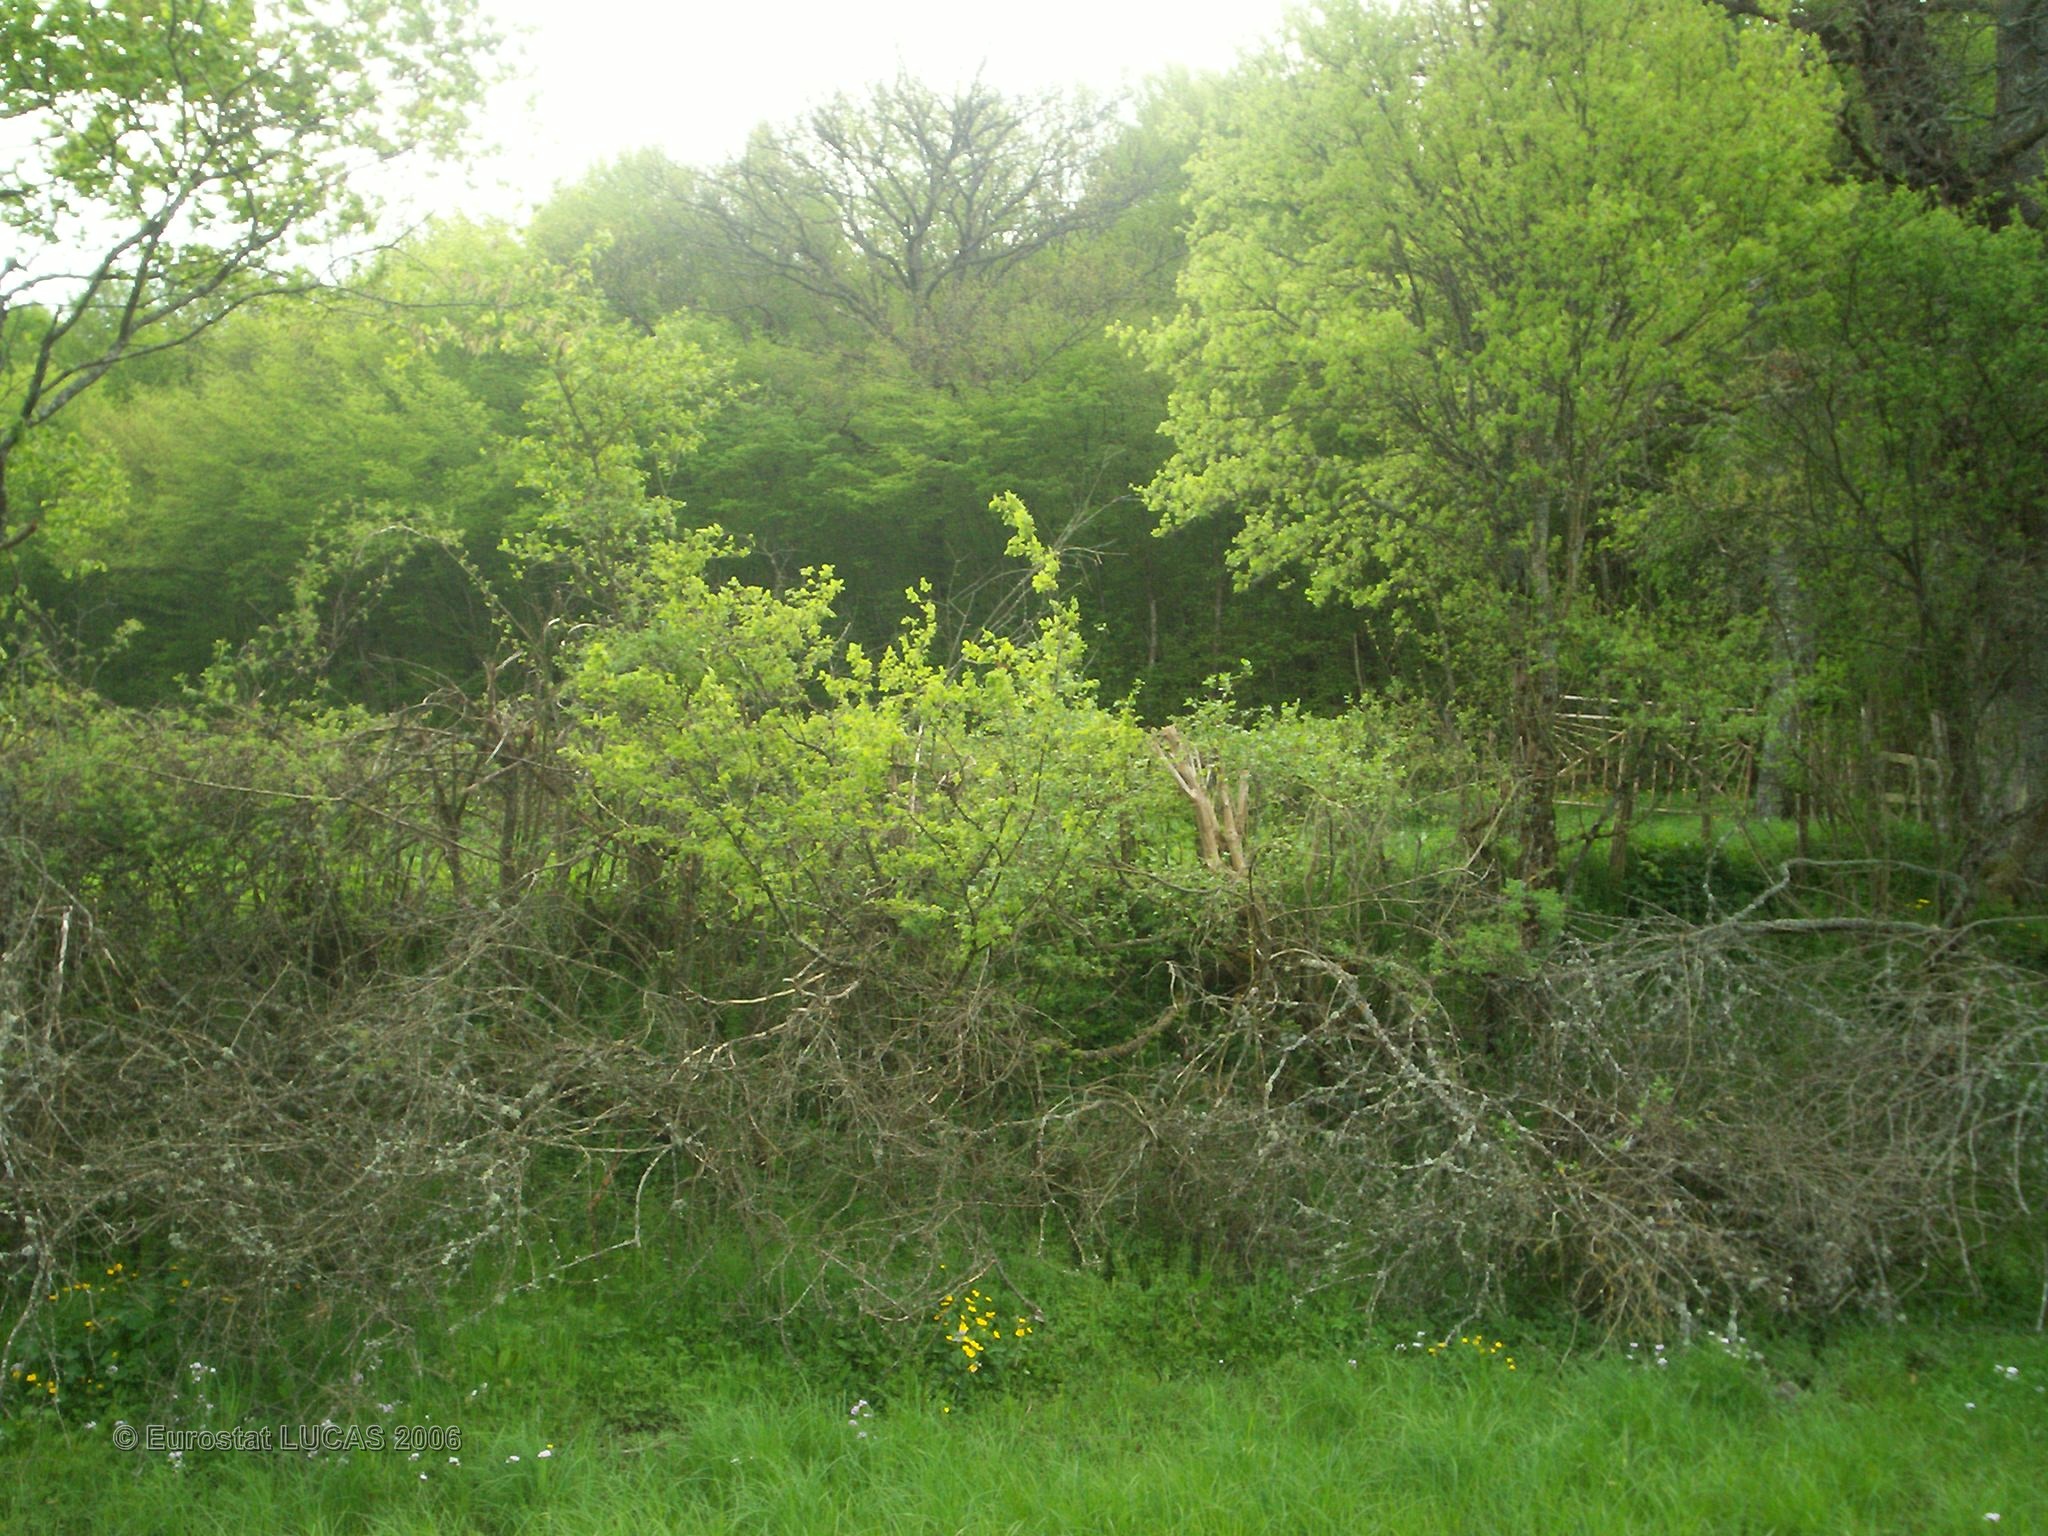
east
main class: Grassland
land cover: Grassland without tree/shrub cover
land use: Agriculture (excluding fallow land and kitchen gardens)
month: May
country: FR
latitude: 47.4475
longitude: 4.0168
